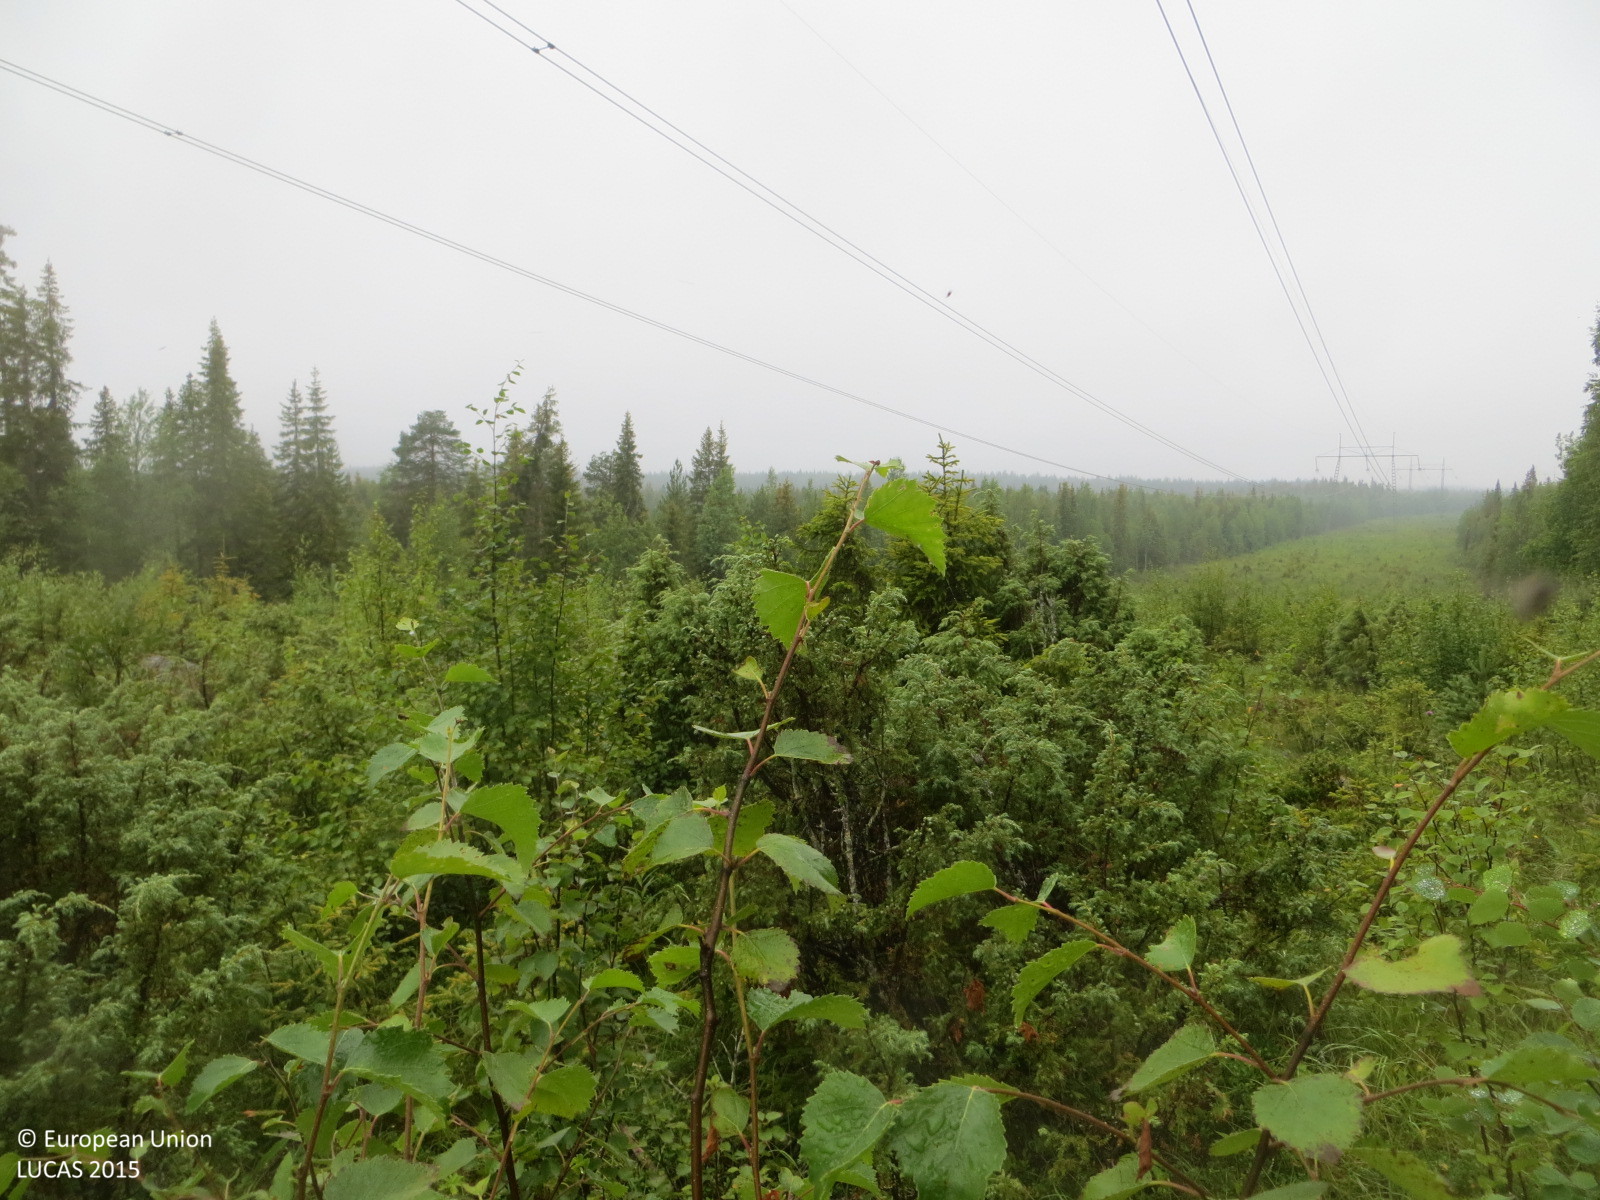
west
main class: Artificial land
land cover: Other artificial areas
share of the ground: > 75 %
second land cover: Other mixed woodland
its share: > 75 %
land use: Electricity, gas and thermal power distribution
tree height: < 5 m
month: August
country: FI
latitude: 66.0928
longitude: 25.4824
